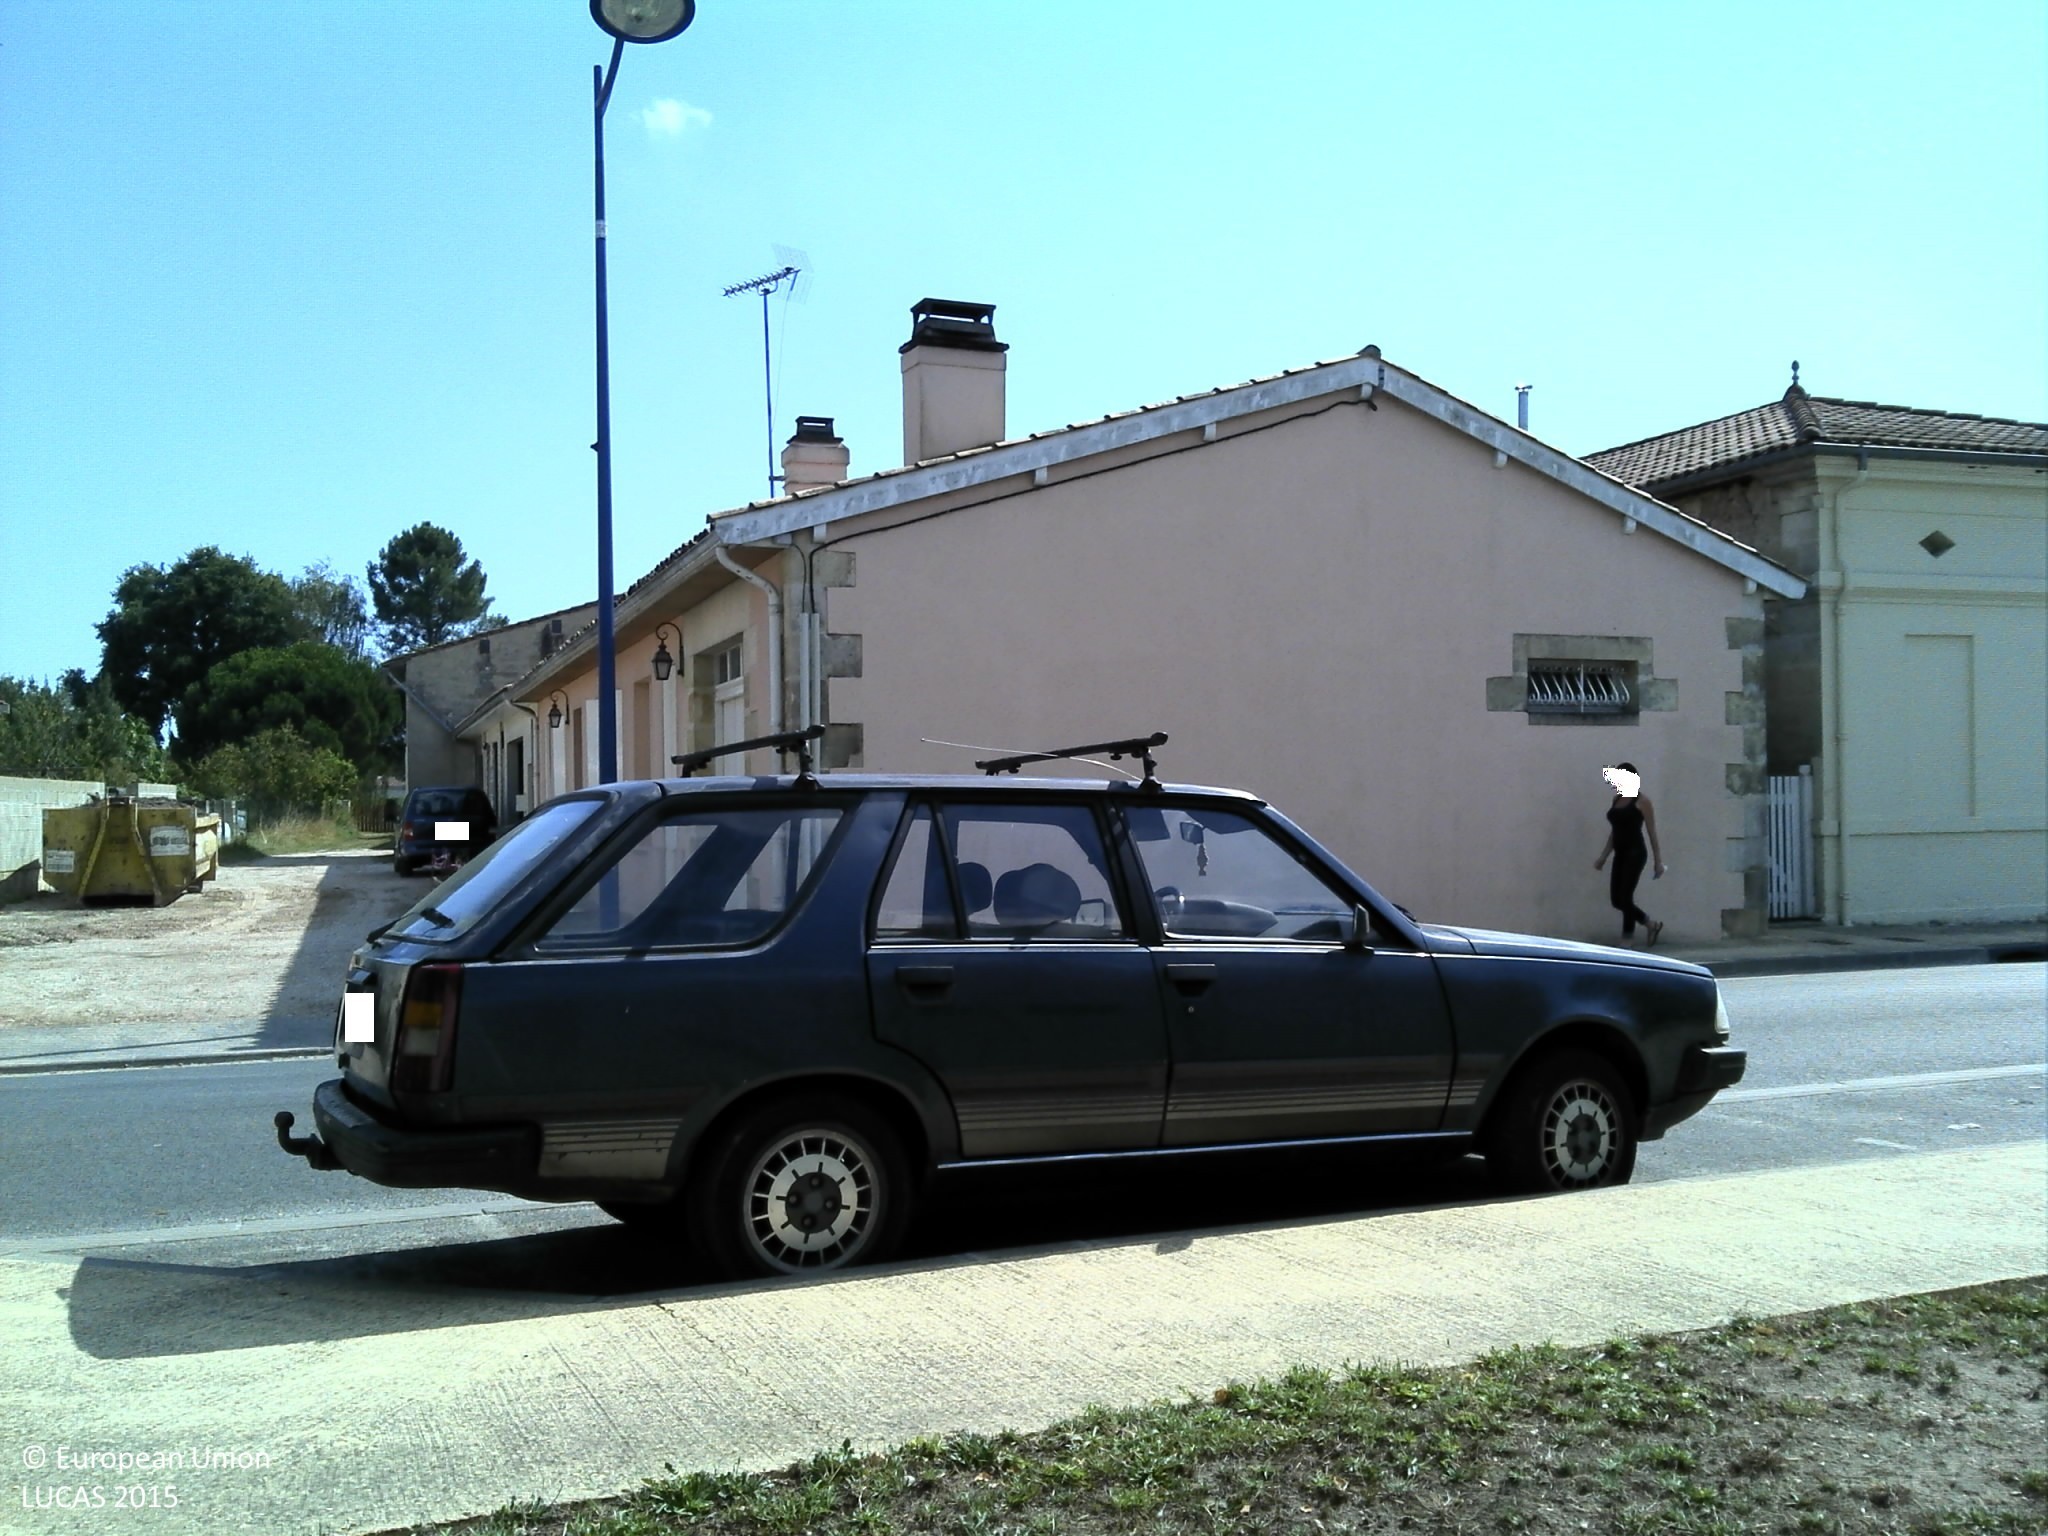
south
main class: Grassland
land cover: Grassland without tree/shrub cover
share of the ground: > 75 %
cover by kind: herbaceous plants 100 %
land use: Residential
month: August
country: FR
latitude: 44.9965
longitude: -0.6887
